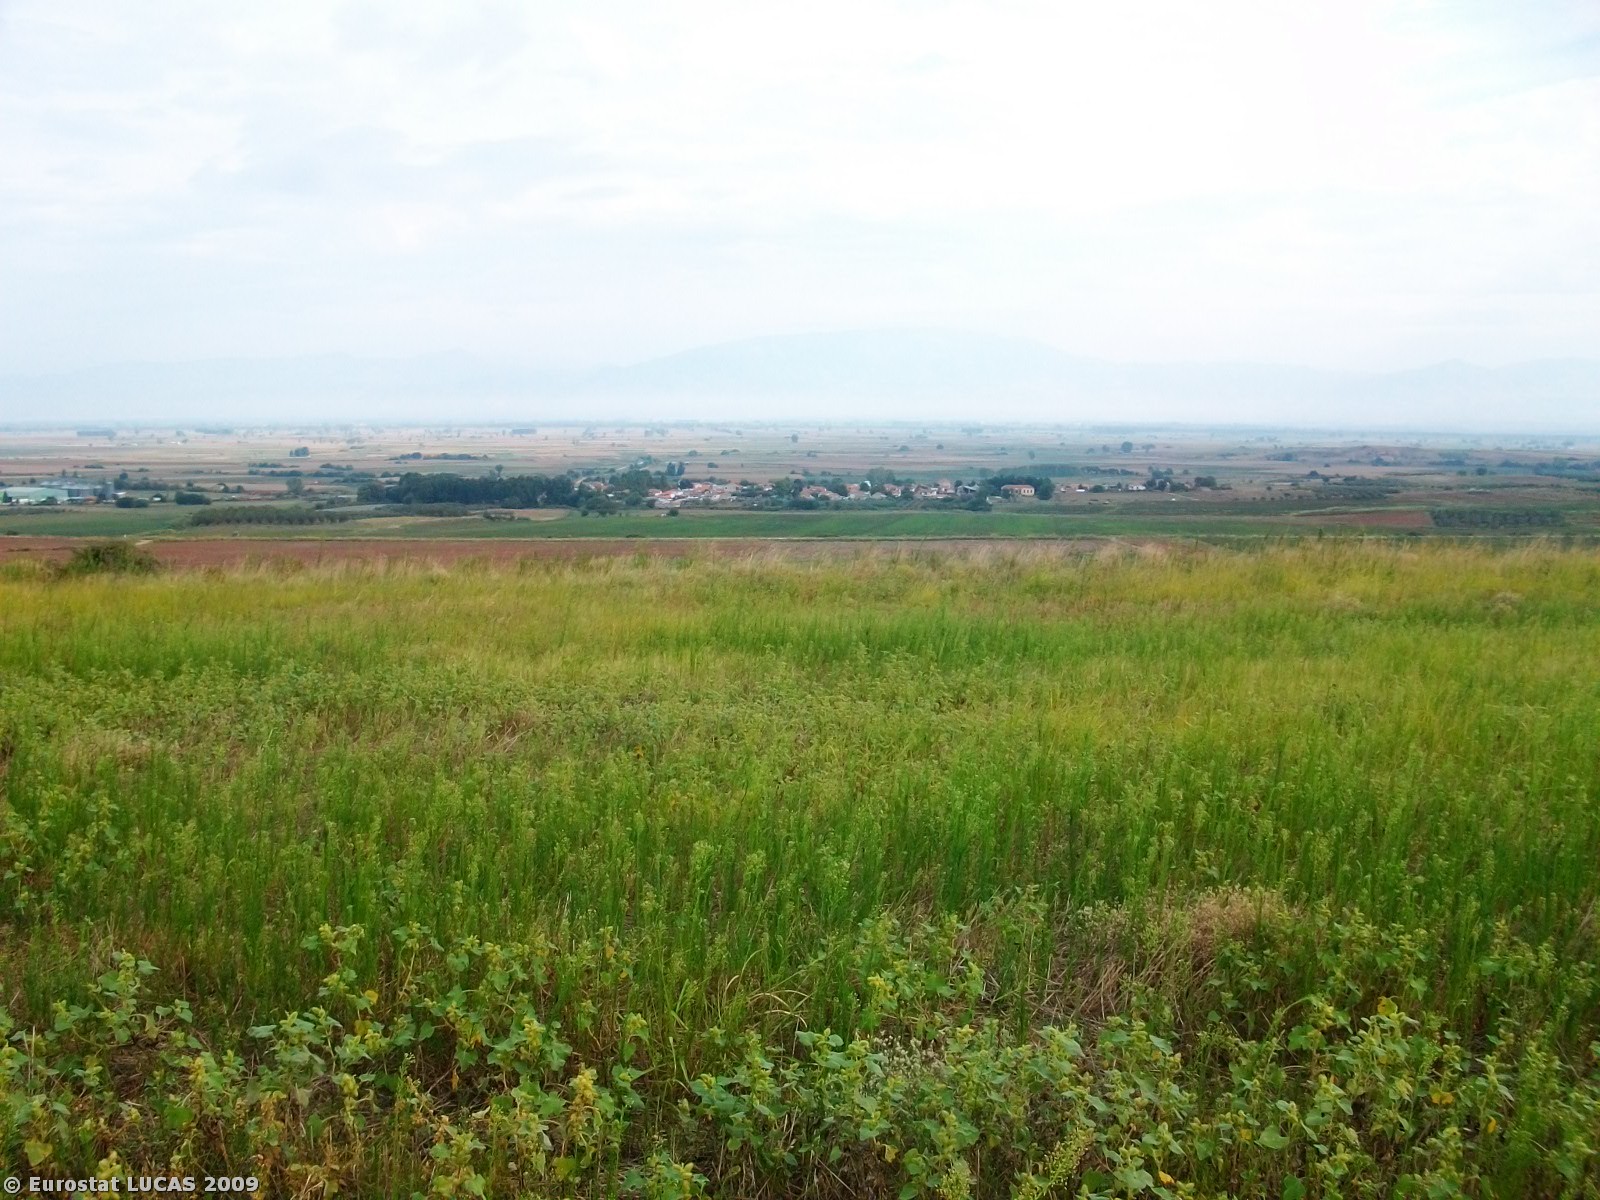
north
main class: Cropland
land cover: Durum wheat
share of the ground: 50 - 75 %
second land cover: Spontaneously vegetated surfaces
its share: 50 - 75 %
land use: Agriculture (excluding fallow land and kitchen gardens)
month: September
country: GR
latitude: 40.8892
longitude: 23.6081
